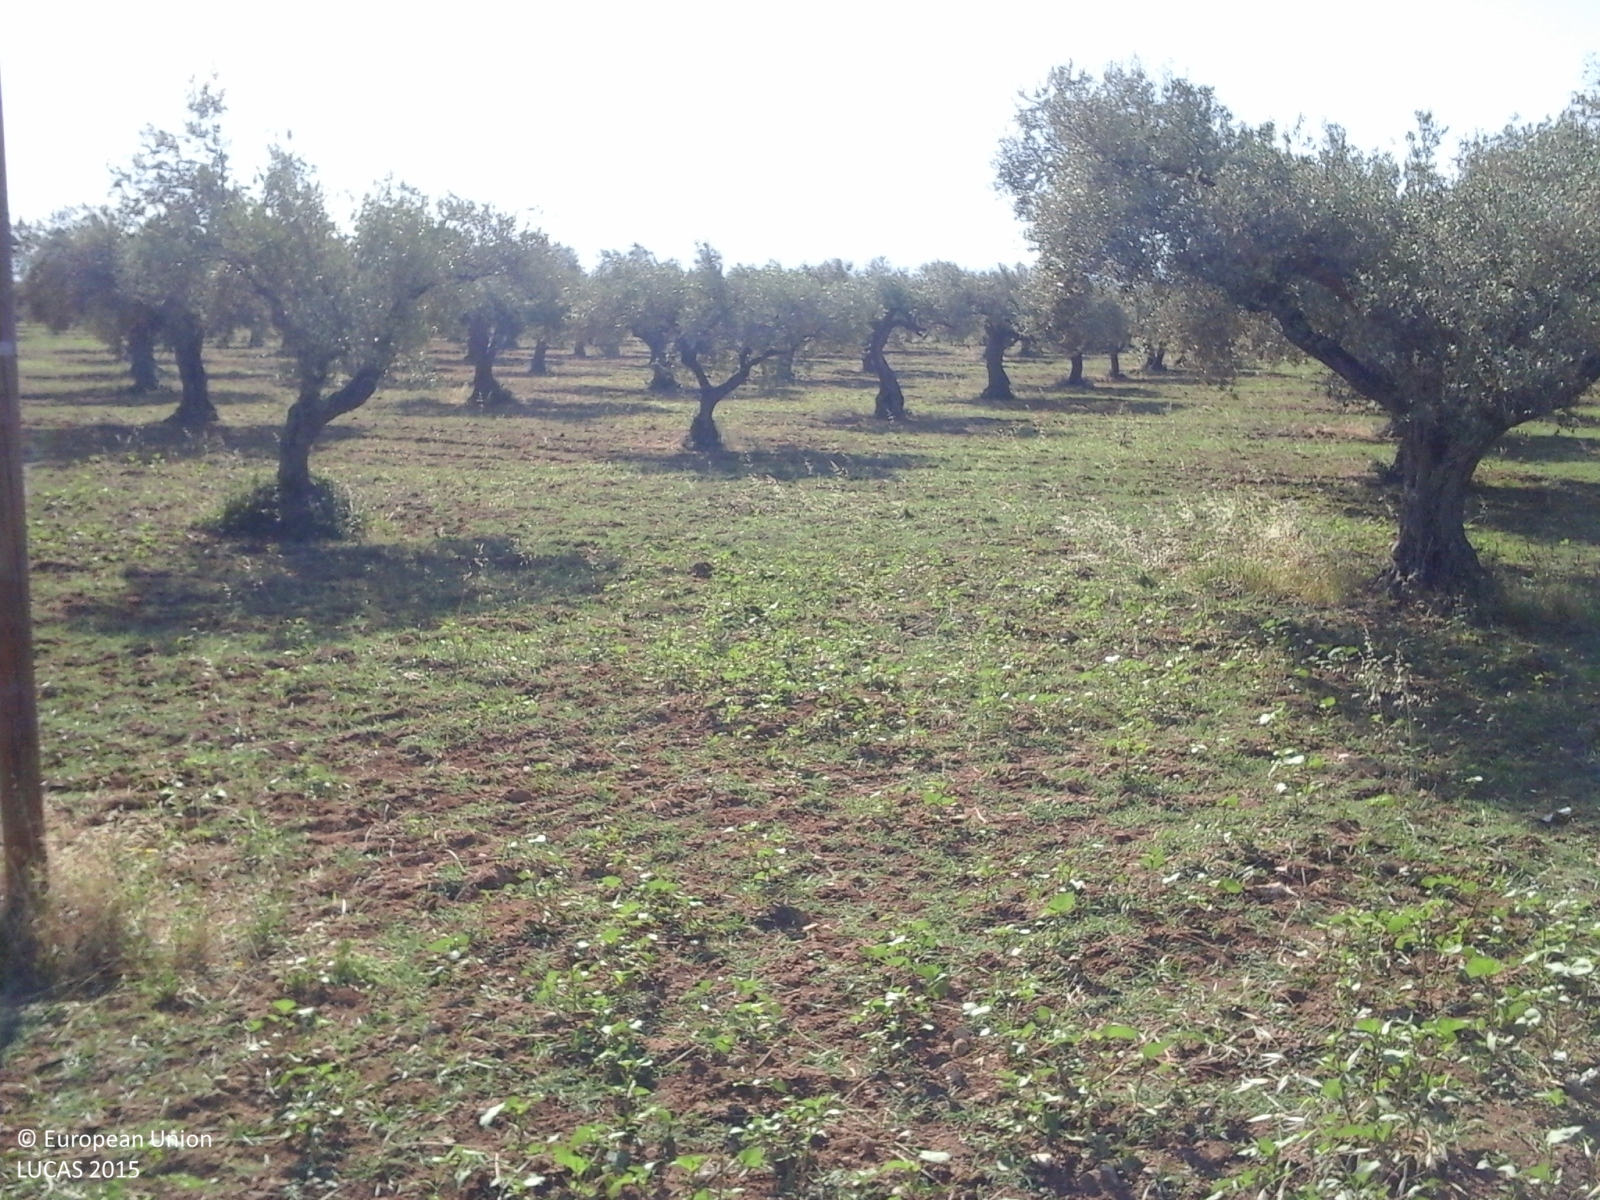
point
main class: Cropland
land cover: Olive groves
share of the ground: > 75 %
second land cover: Spontaneously vegetated surfaces
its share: > 75 %
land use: Agriculture (excluding fallow land and kitchen gardens)
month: May
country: IT
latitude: 37.0379
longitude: 14.5624
